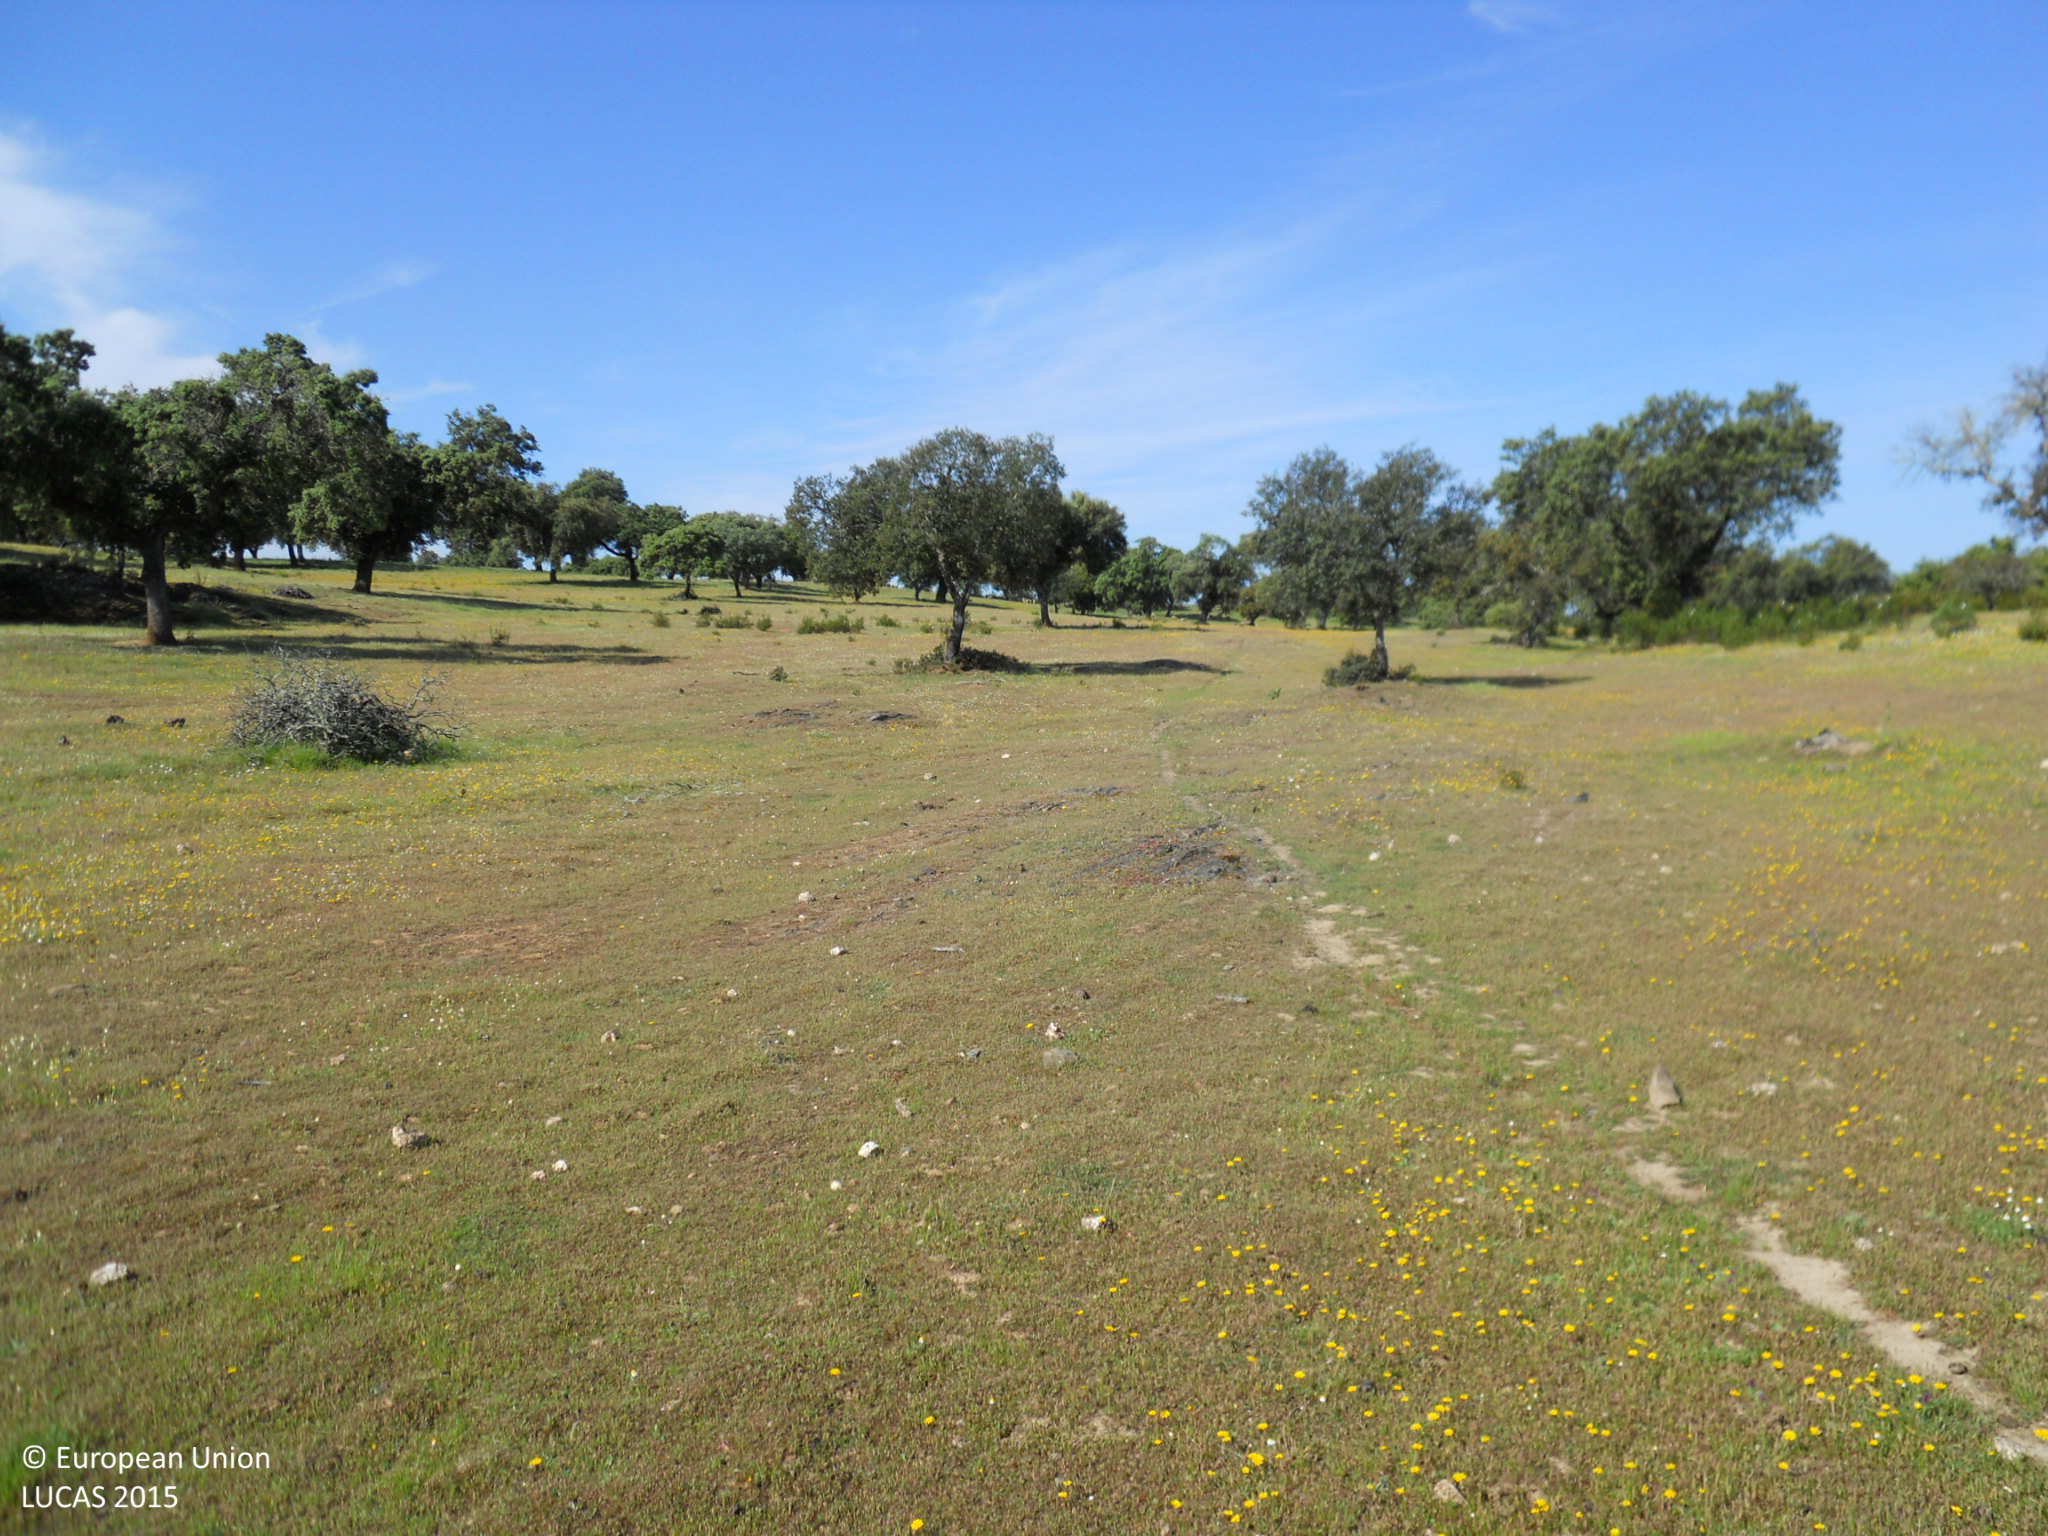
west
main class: Grassland
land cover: Grassland with sparse tree/shrub cover
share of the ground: > 75 %
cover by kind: herbaceous plants 95 %, broadleaved forest trees 5 %
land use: Agriculture (excluding fallow land and kitchen gardens)
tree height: > 5 m
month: April
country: ES
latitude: 39.1913
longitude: -6.9203
